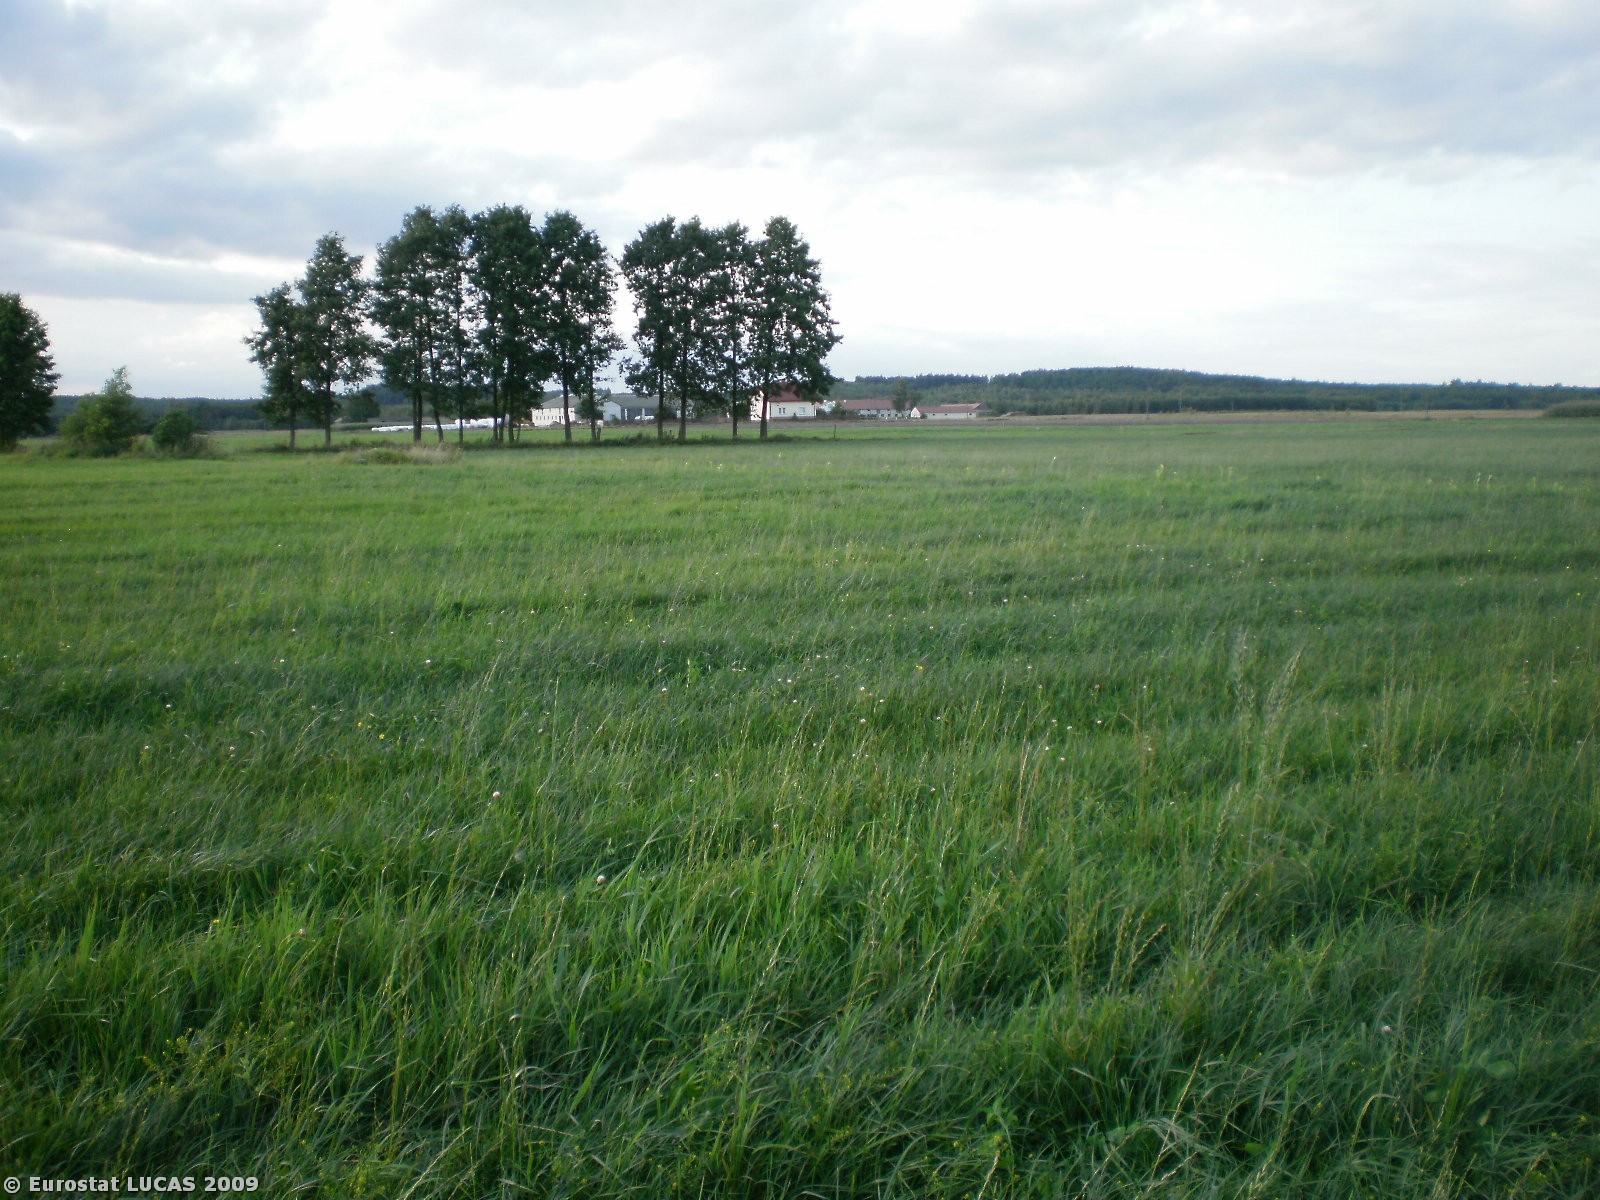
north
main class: Grassland
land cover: Grassland without tree/shrub cover
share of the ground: > 75 %
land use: Agriculture (excluding fallow land and kitchen gardens)
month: August
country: PL
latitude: 53.0873
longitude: 20.9274
